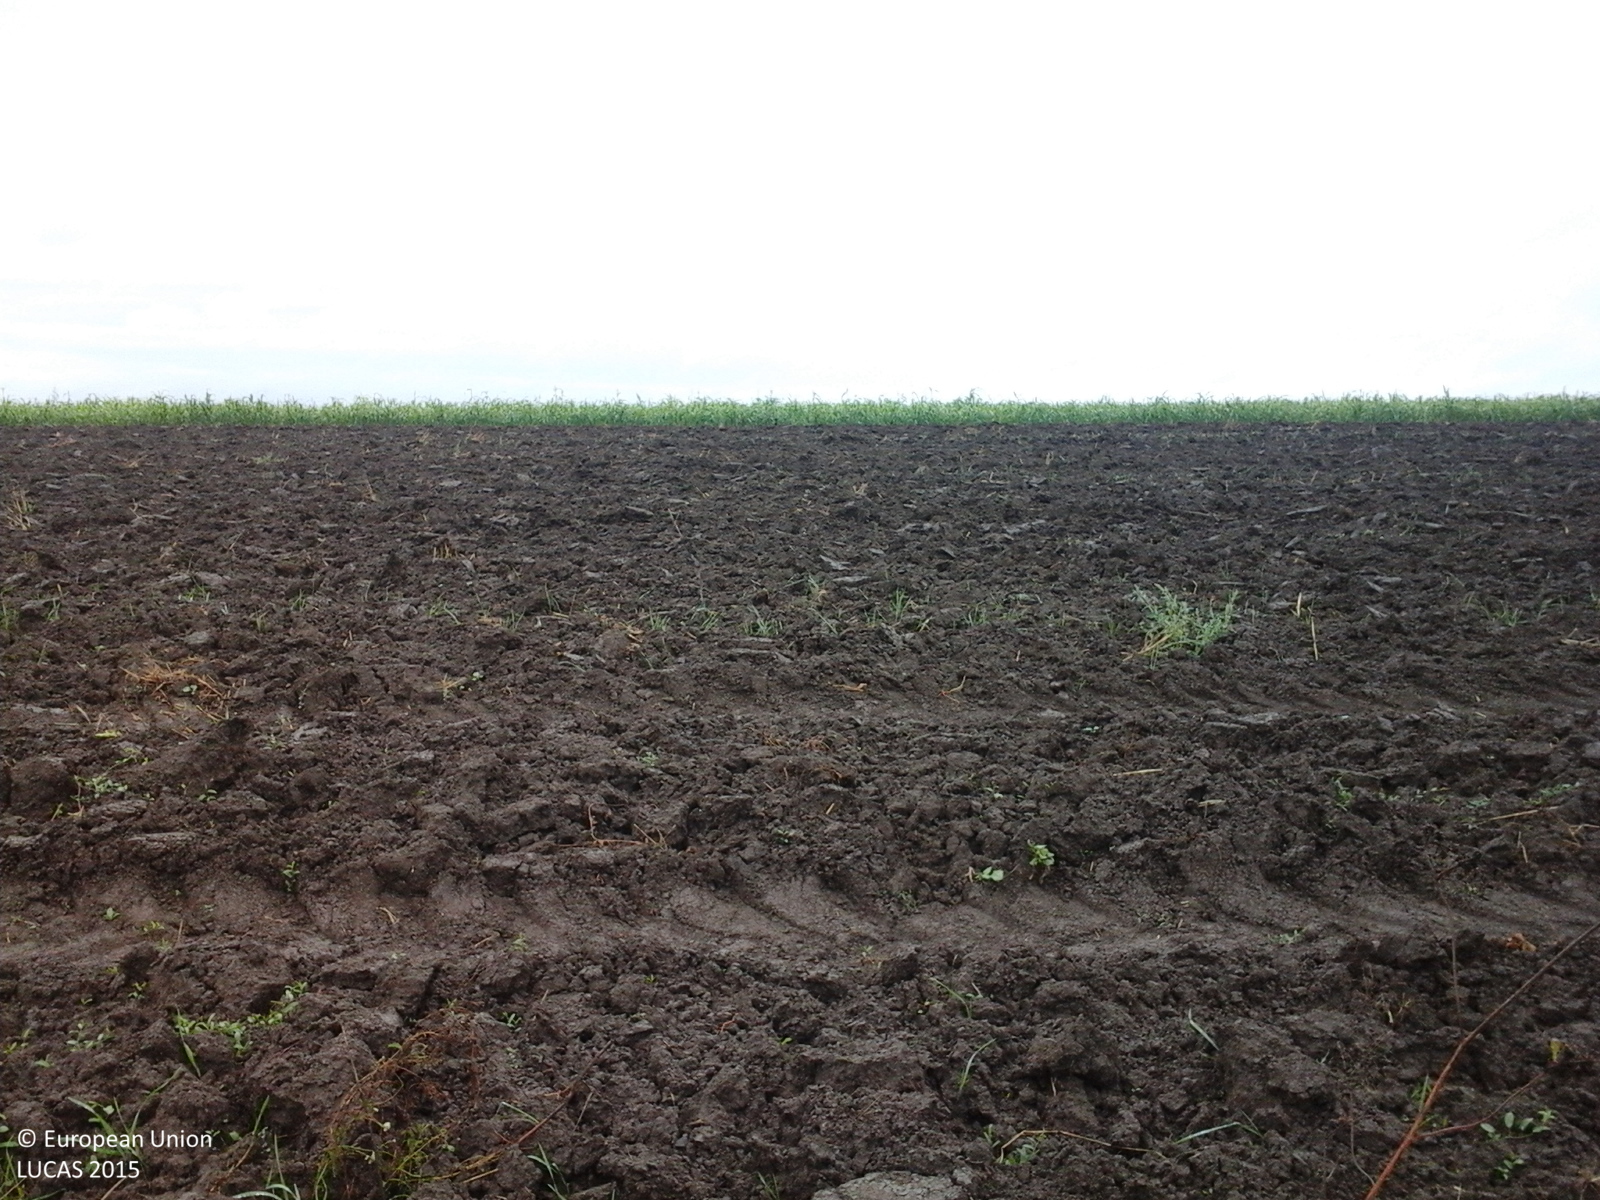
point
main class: Cropland
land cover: Maize
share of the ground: < 10 %
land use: Agriculture (excluding fallow land and kitchen gardens)
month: September
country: RO
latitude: 46.8609
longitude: 21.6237
